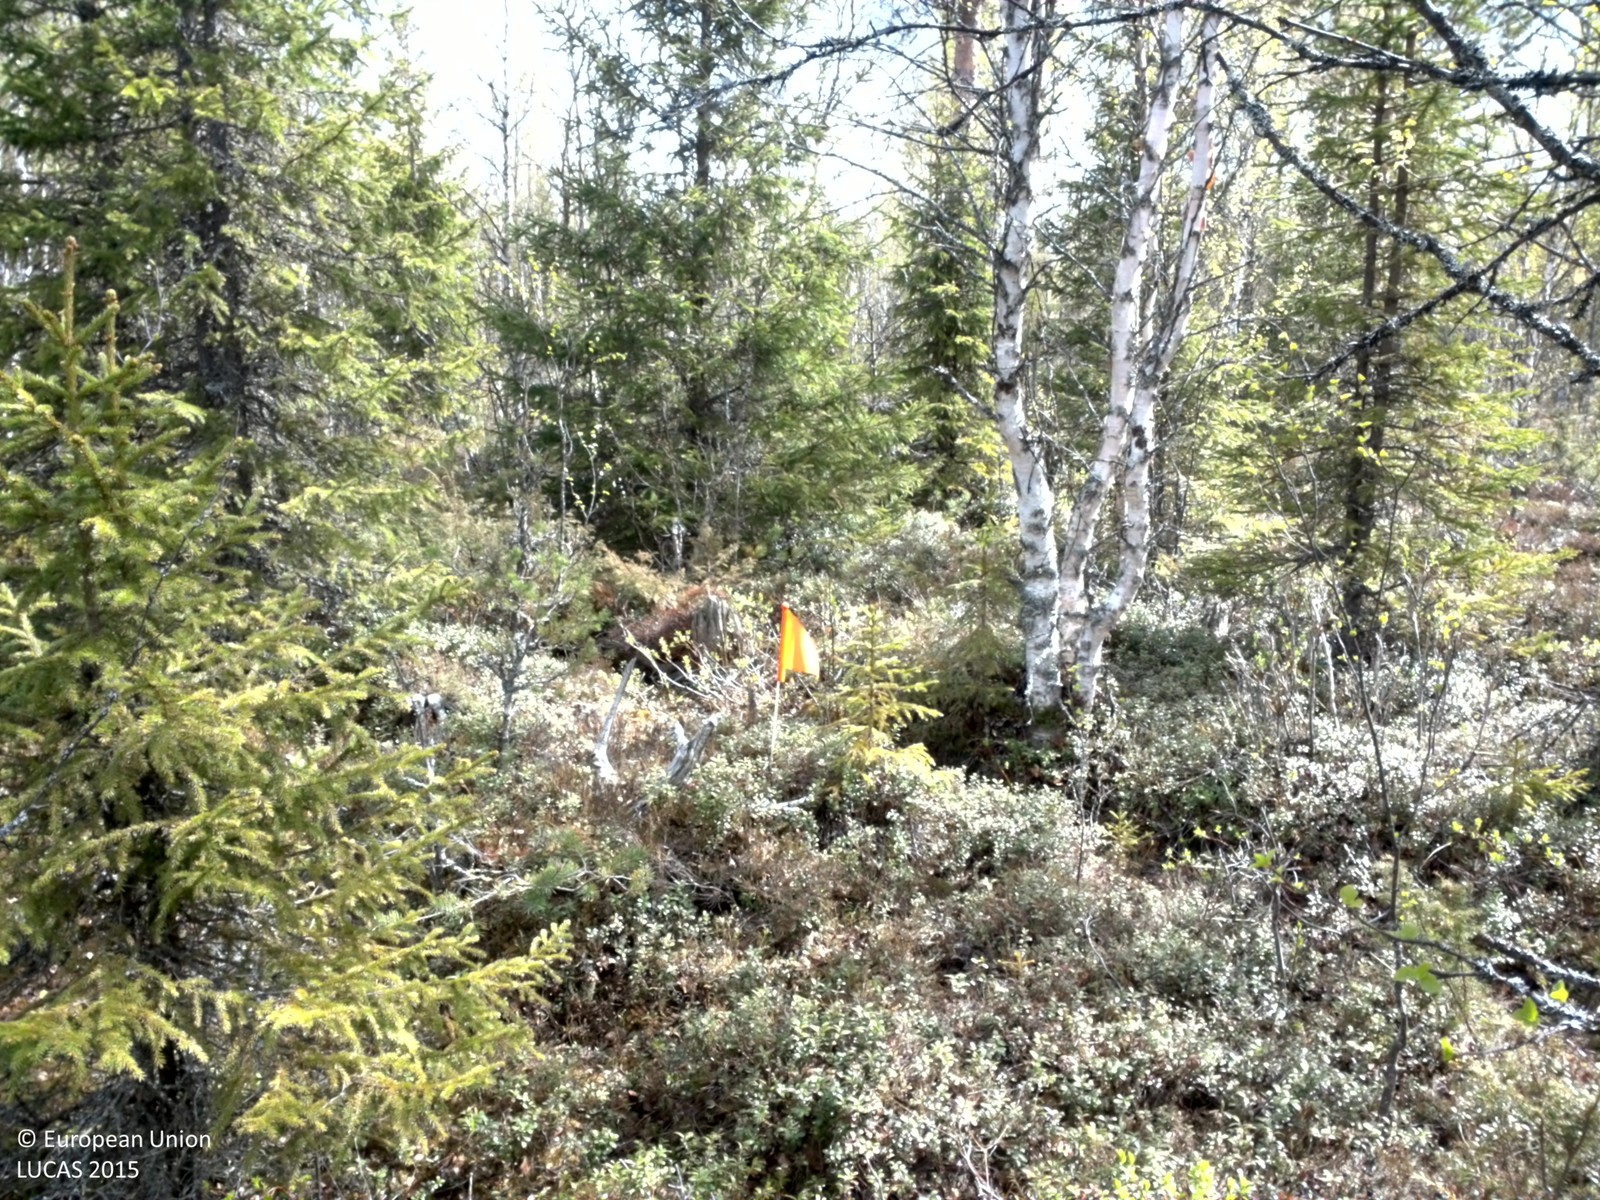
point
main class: Woodland
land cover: Spruce dominated mixed woodland
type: boreal forest
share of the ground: 50 - 75 %
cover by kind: coniferous forest trees 45 %, shrubs 20 %, herbaceous plants 20 %, broadleaved forest trees 15 %
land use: Forestry
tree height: > 5 m
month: June
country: SE
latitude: 63.4284
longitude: 14.5665
